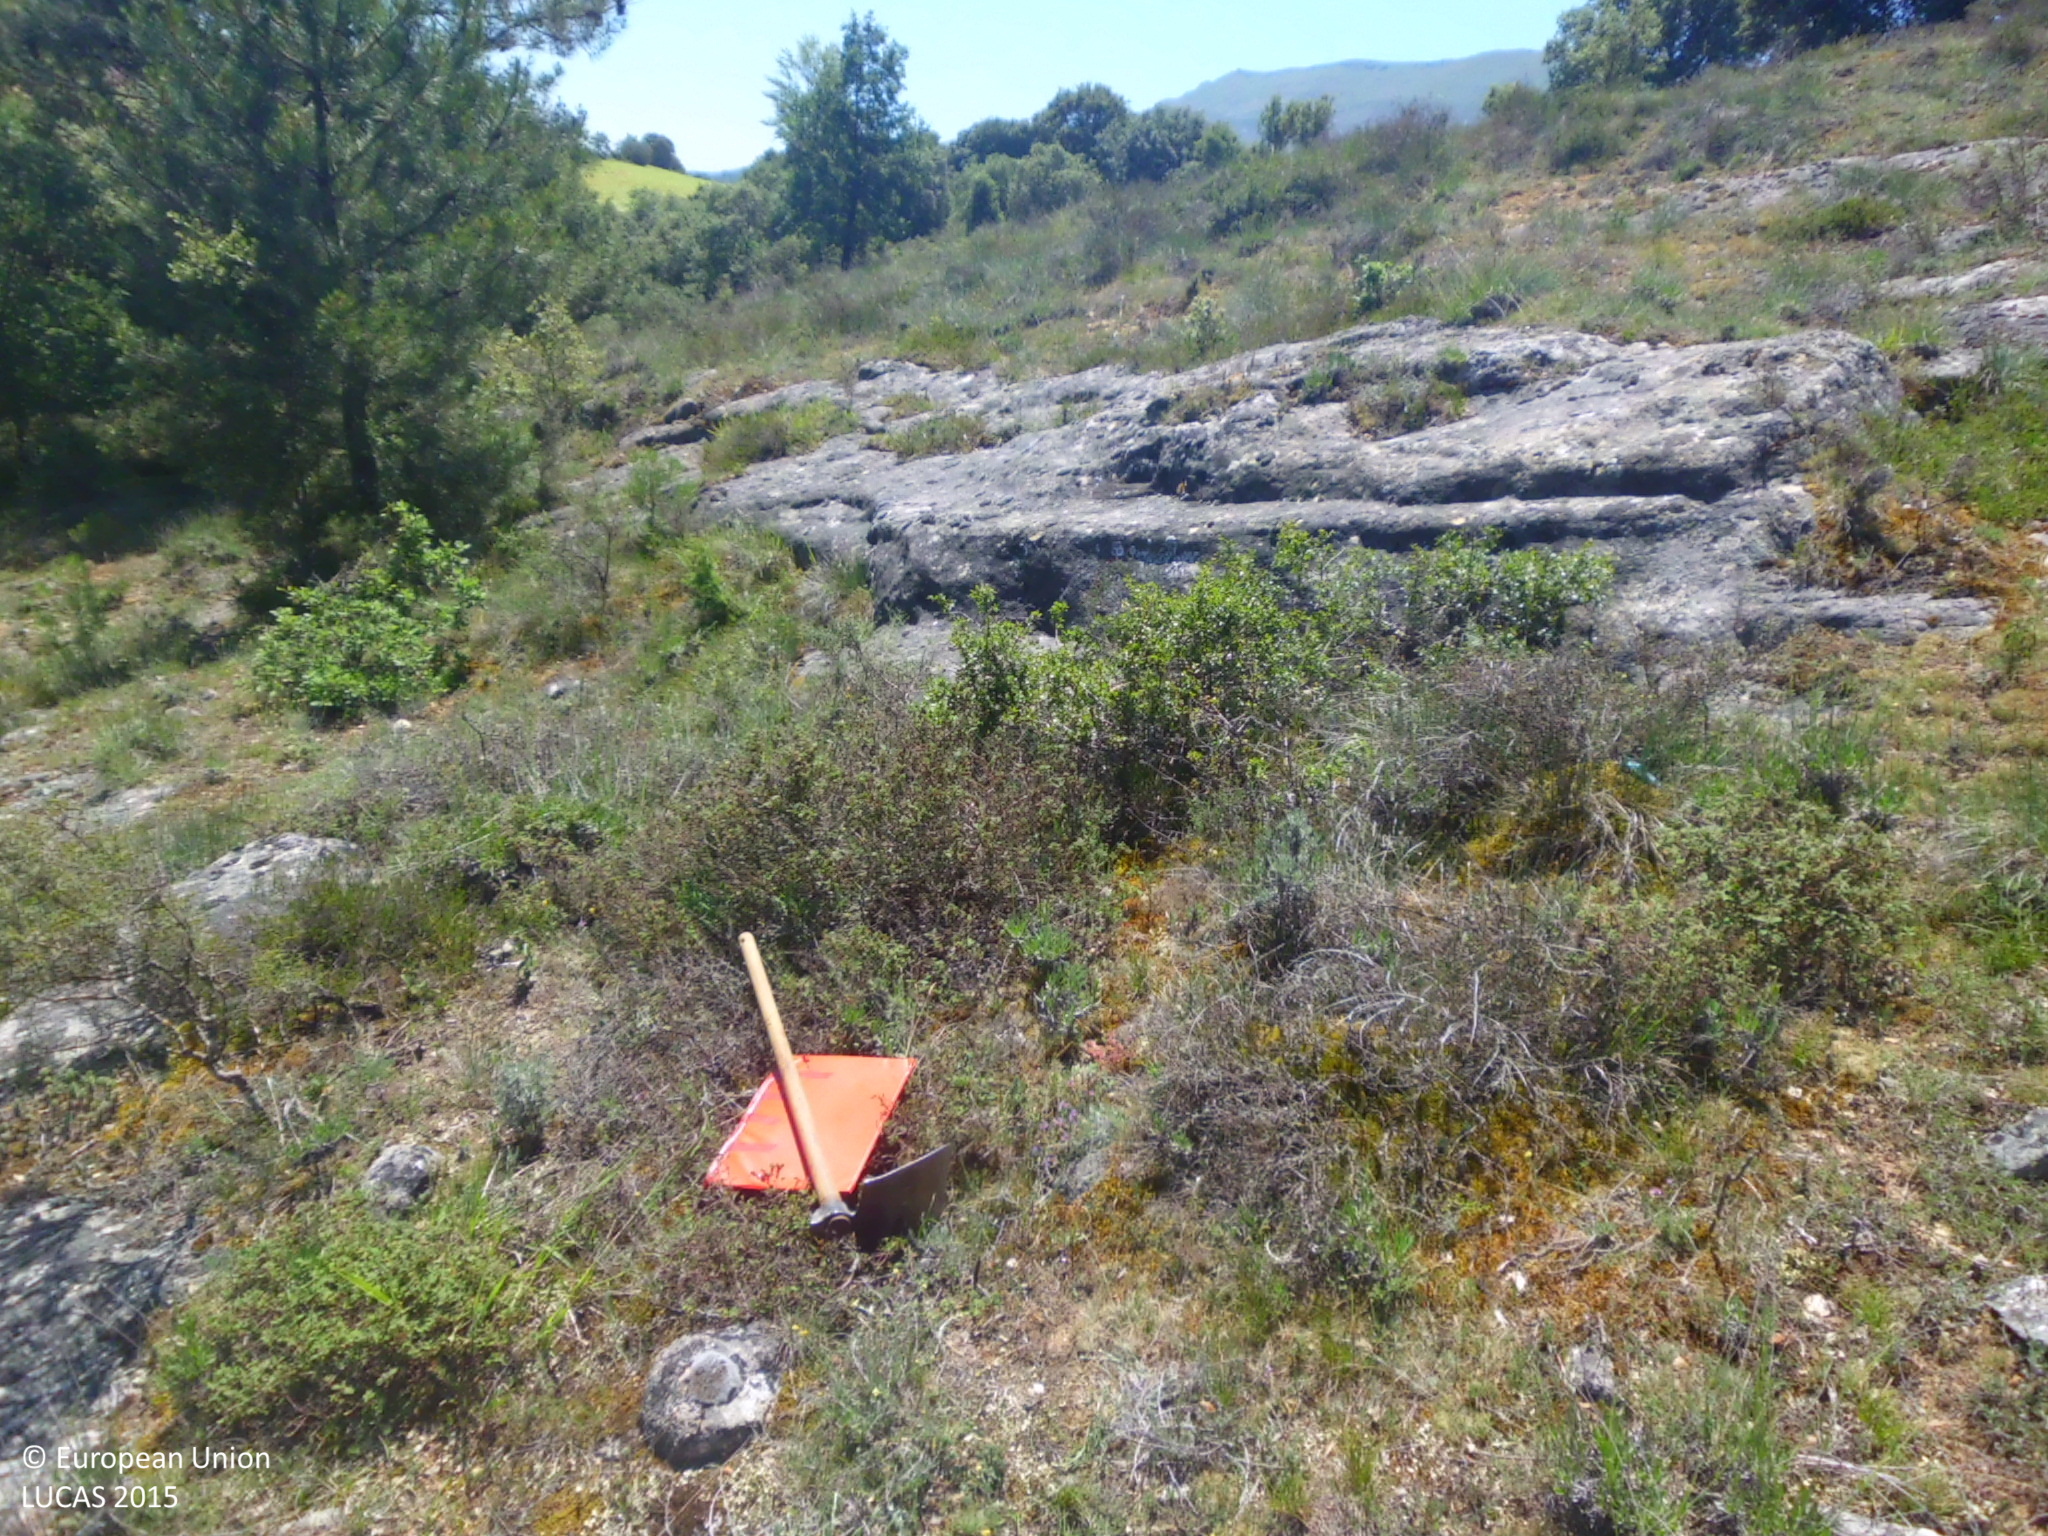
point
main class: Shrubland
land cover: Shrubland with sparse tree cover
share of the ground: 25 - 50 %
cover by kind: herbaceous plants 50 %, shrubs 35 %, consolidated bare surface 10 %, coniferous forest trees 5 %
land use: Semi-natural and natural areas not in use
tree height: < 5 m
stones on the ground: 10 - 25 %
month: June
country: ES
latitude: 42.8944
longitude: -3.5218
